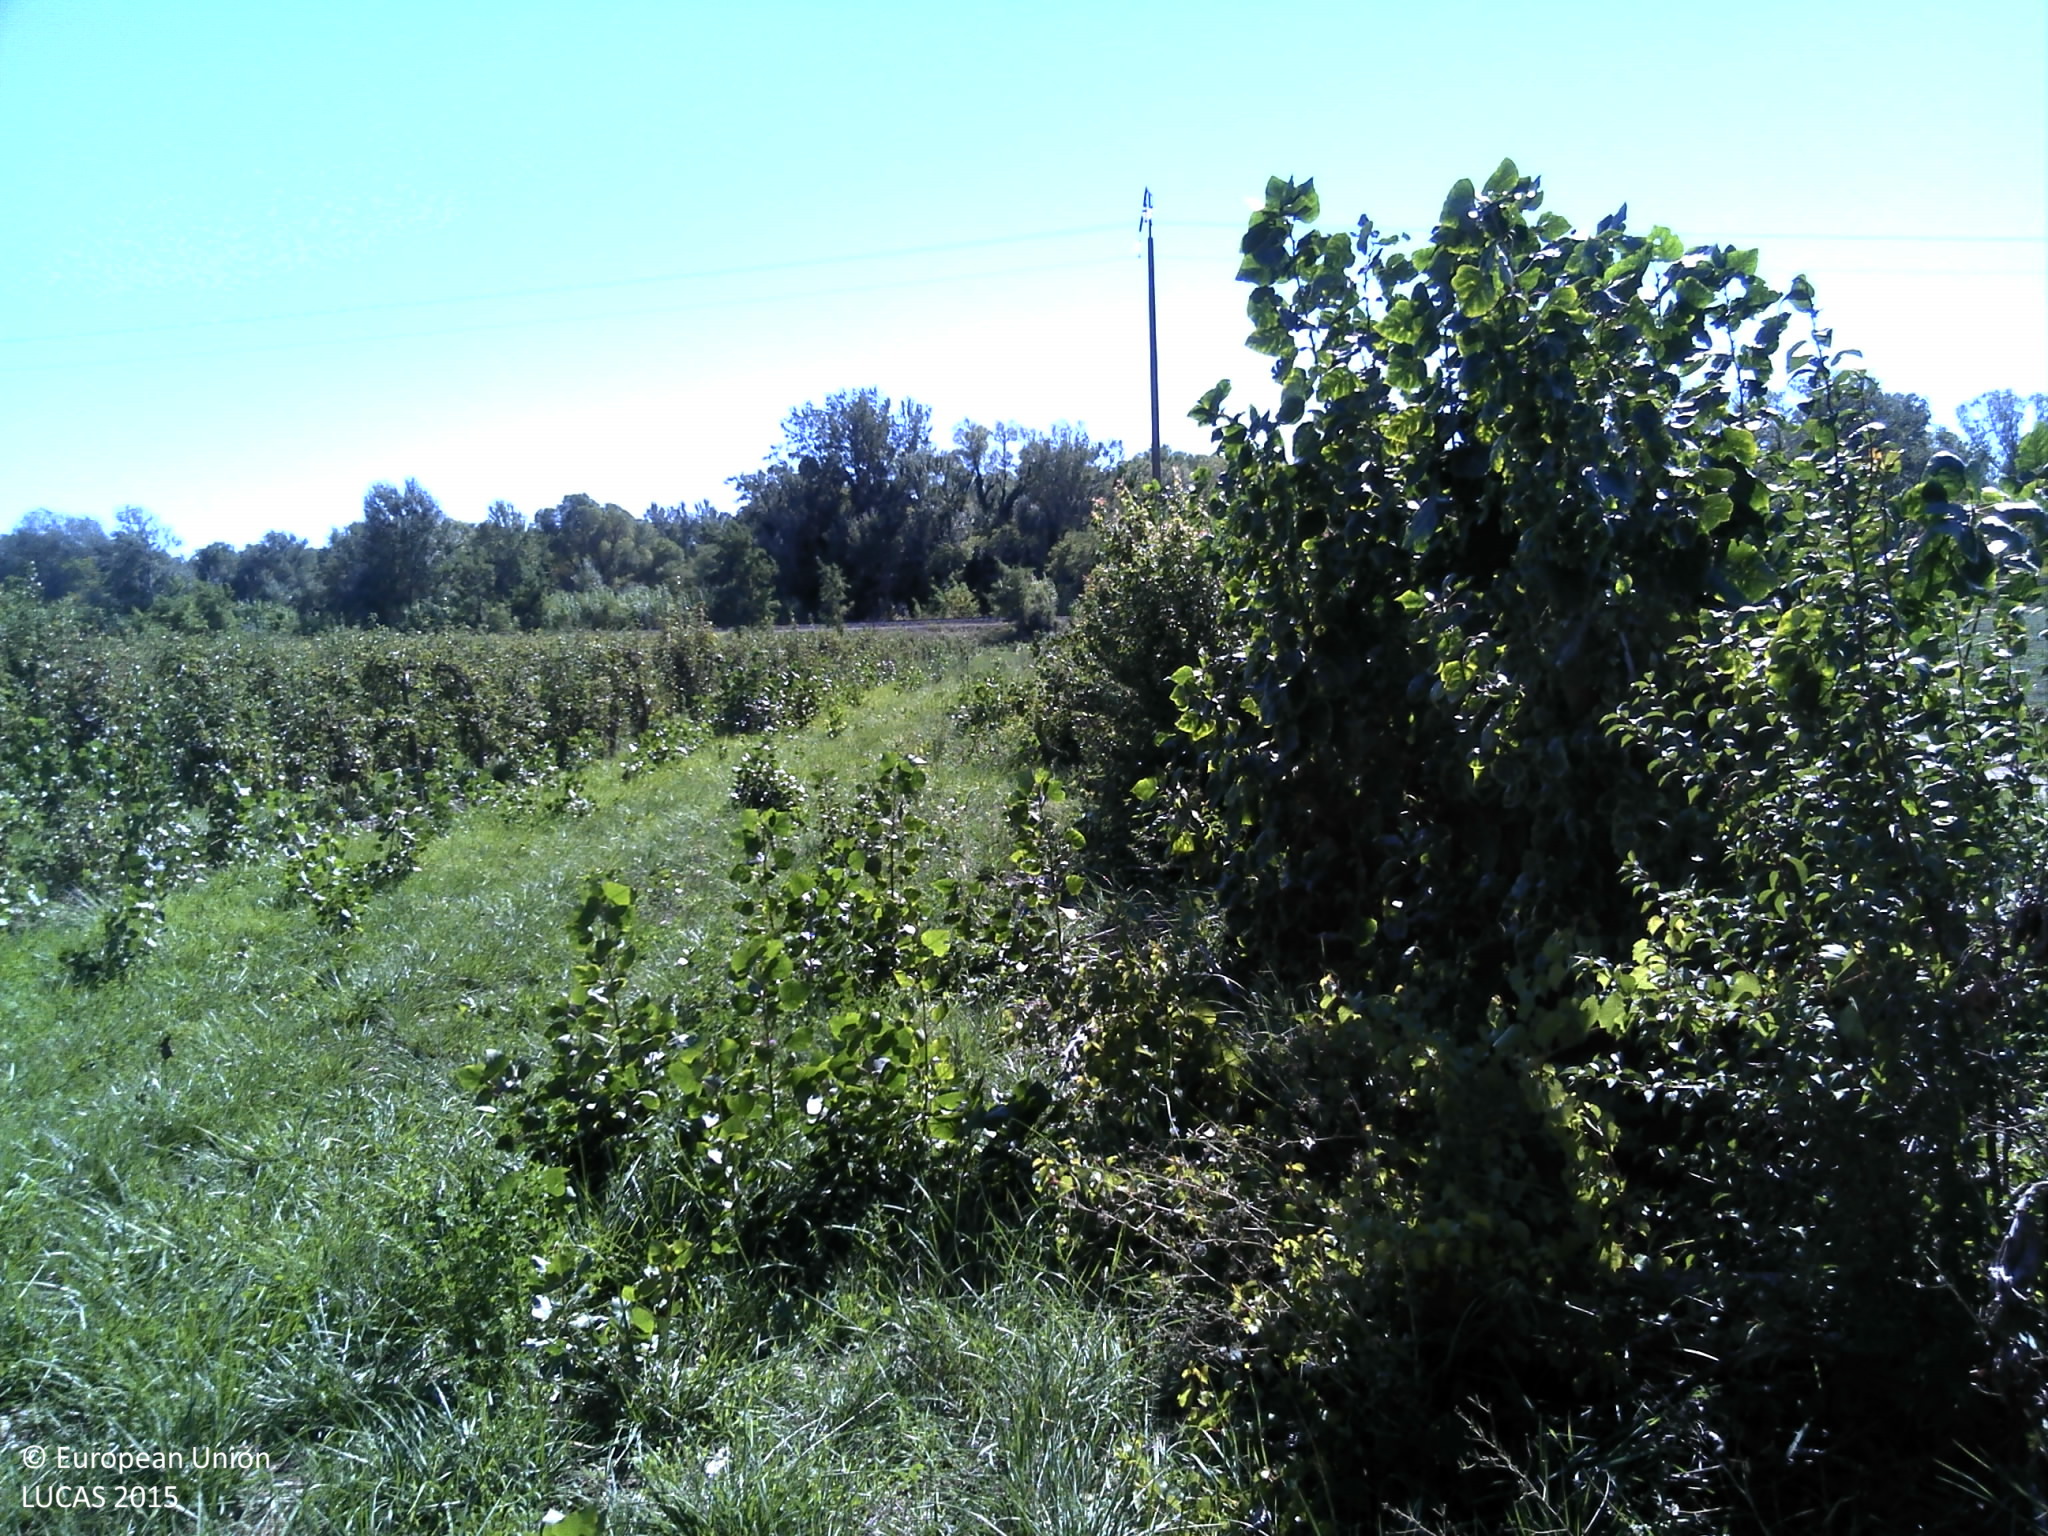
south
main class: Cropland
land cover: Pear fruit
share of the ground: 10 - 25 %
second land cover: Grassland without tree/shrub cover
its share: > 75 %
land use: Agriculture (excluding fallow land and kitchen gardens)
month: September
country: FR
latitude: 43.7541
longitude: 5.2524
